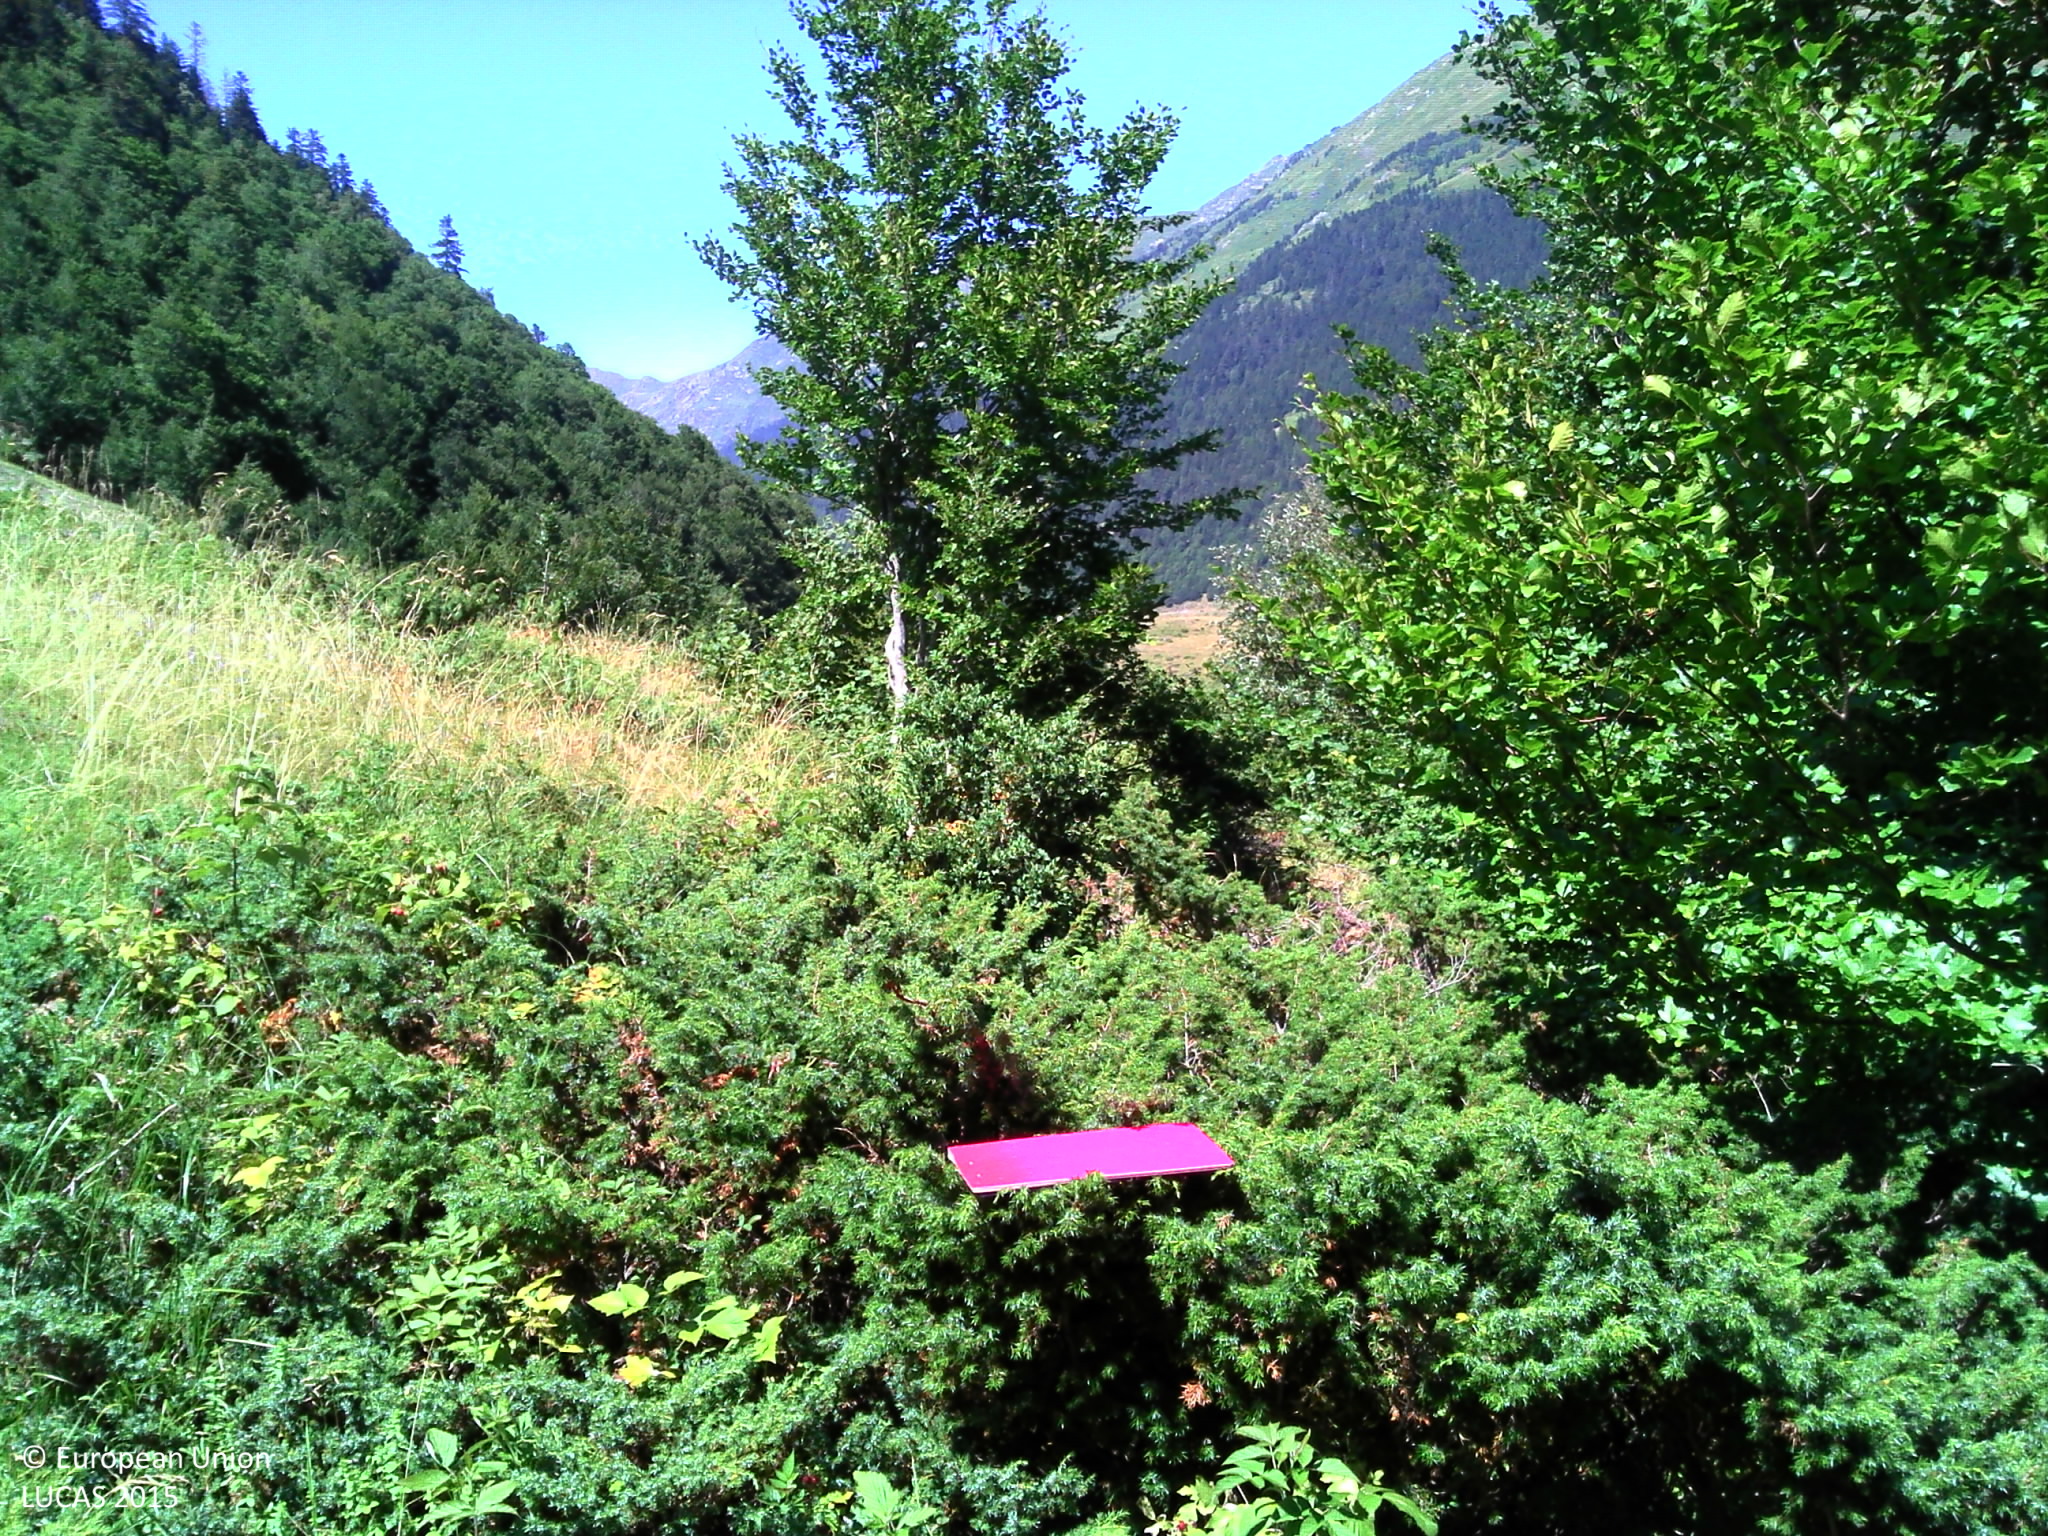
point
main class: Woodland
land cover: Broadleaved woodland
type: beech forest
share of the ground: 25 - 50 %
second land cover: Grassland without tree/shrub cover
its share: 50 - 75 %
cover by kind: herbaceous plants 40 %, broadleaved forest trees 35 %, shrubs 15 %, lichens and mosses 5 %, consolidated bare surface 5 %
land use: Forestry
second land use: Agriculture (excluding fallow land and kitchen gardens)
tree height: > 5 m
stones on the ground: 10 - 25 %
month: July
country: FR
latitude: 42.8278
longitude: -0.3890
